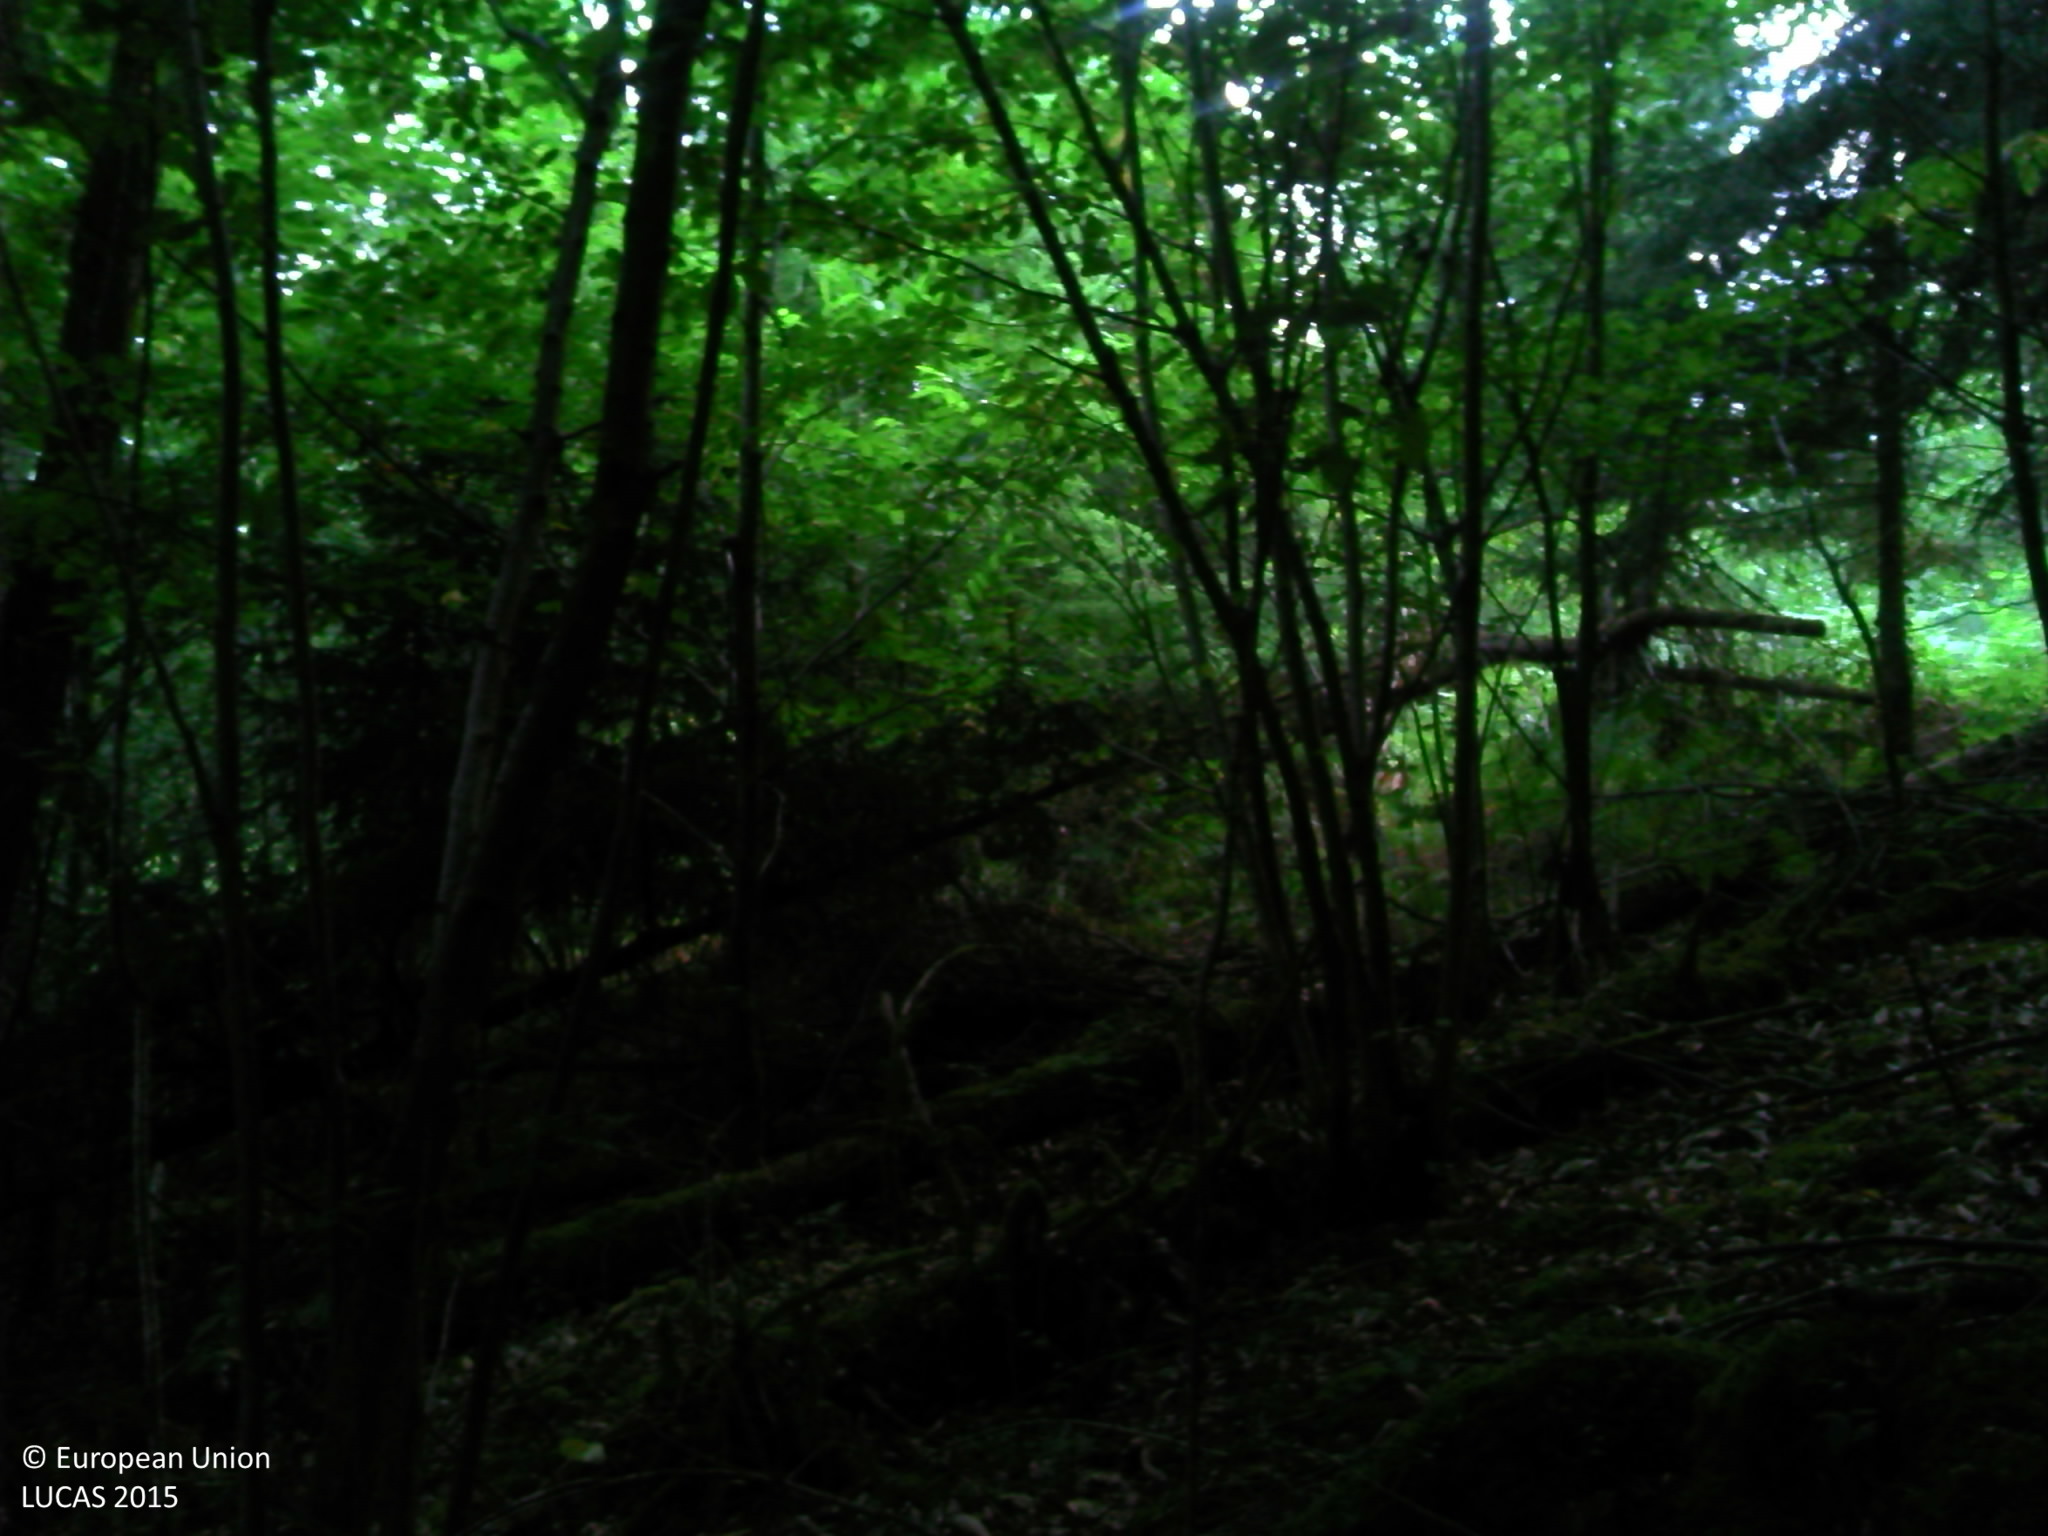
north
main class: Woodland
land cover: Spruce dominated mixed woodland
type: acidophilous oak and oak-birch forest
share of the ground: > 75 %
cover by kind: broadleaved forest trees 50 %, coniferous forest trees 30 %, unconsolidated bare surface 10 %, herbaceous plants 5 %, lichens and mosses 5 %
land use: Forestry
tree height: > 5 m
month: July
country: FR
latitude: 45.6671
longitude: 0.6300
